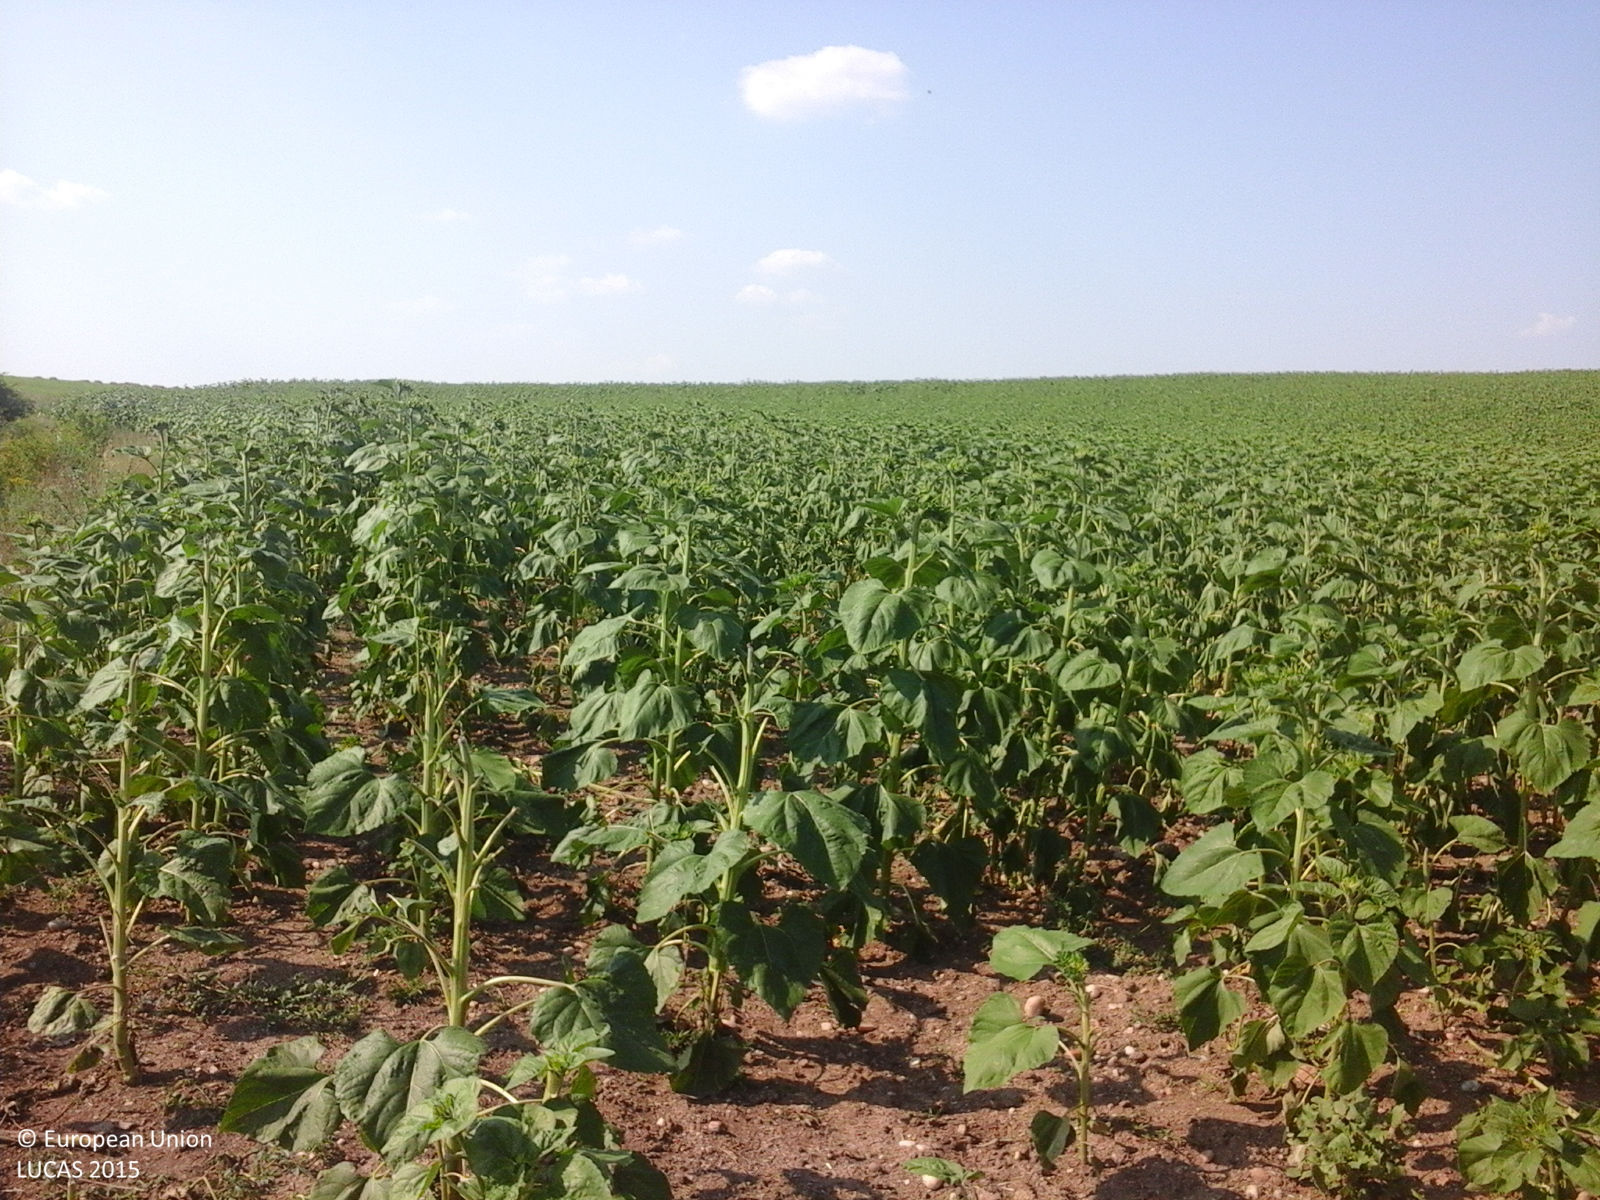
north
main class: Cropland
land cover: Sunflower
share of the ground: > 75 %
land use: Agriculture (excluding fallow land and kitchen gardens)
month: July
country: RO
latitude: 44.6387
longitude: 24.5330
